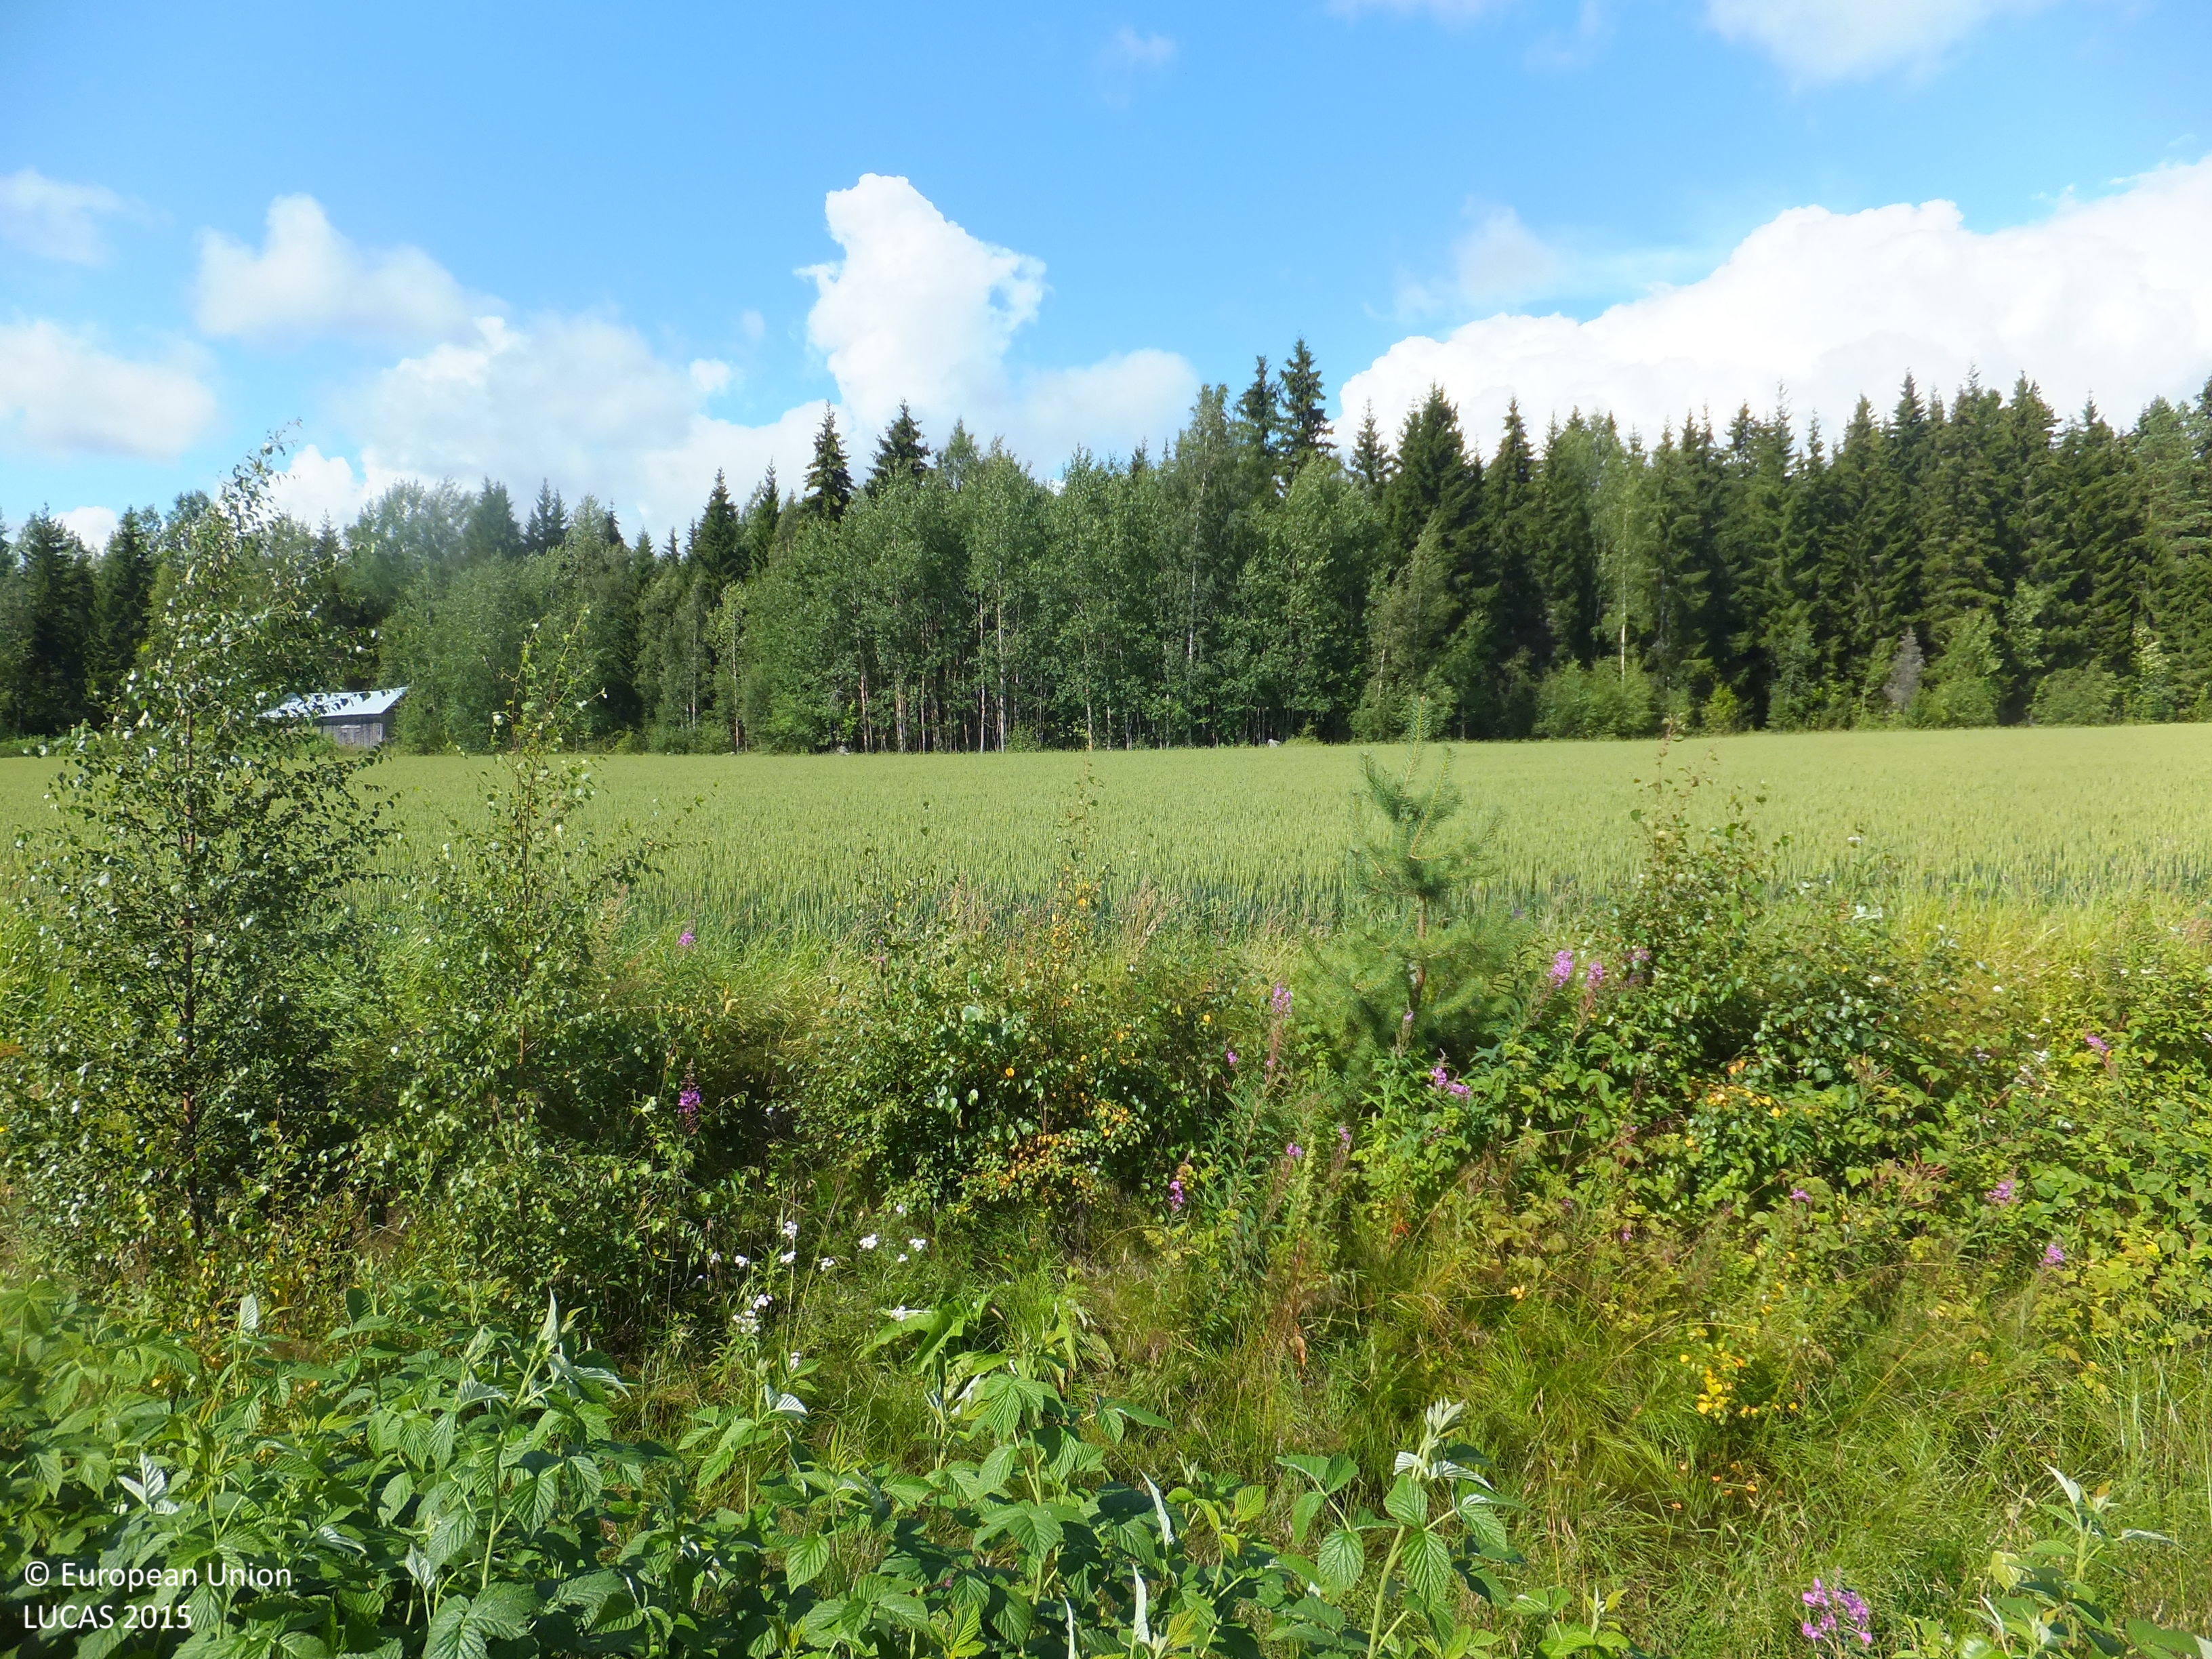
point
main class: Cropland
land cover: Common wheat
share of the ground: > 75 %
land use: Agriculture (excluding fallow land and kitchen gardens)
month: July
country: FI
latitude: 63.0285
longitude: 22.2017
